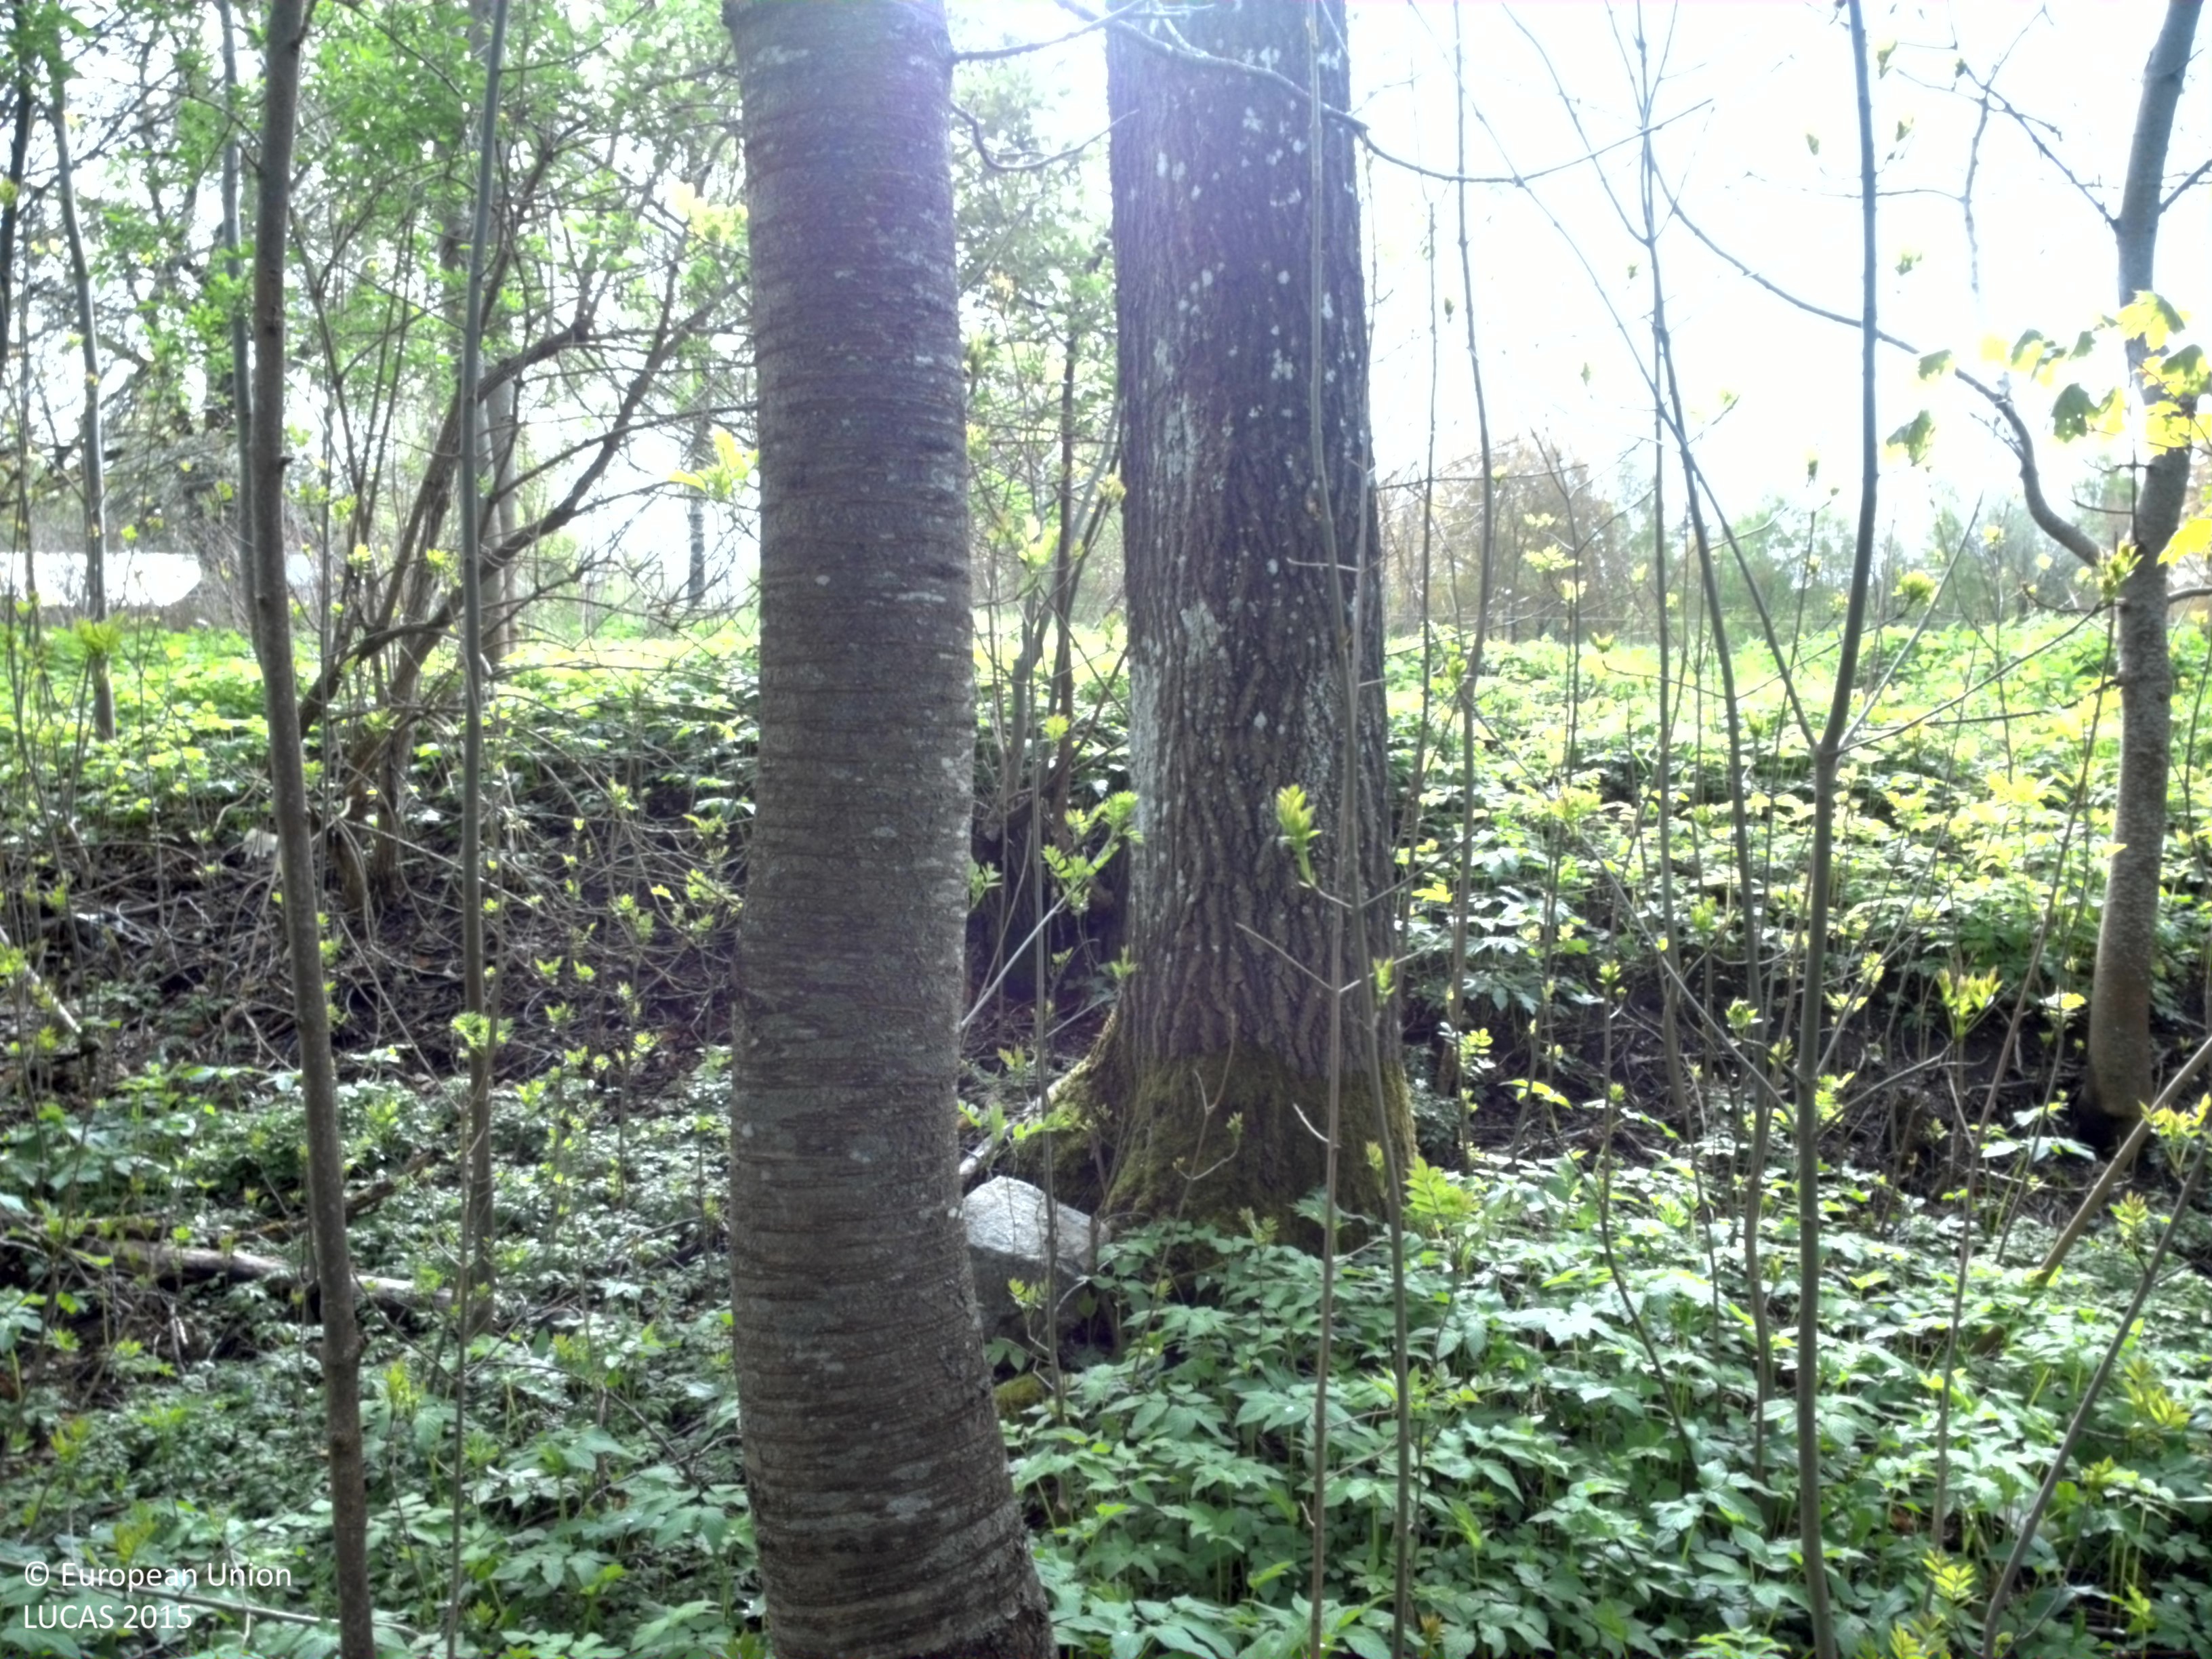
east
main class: Woodland
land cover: Broadleaved woodland
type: boreal forest
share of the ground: 50 - 75 %
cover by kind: broadleaved forest trees 60 %, herbaceous plants 20 %, lichens and mosses 20 %
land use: Amenities, museums, leisure
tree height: > 5 m
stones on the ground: < 10 %
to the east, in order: Broadleaved woodland; Artificial constructions in urban areas
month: May
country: SE
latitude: 56.8545
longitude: 14.8020
